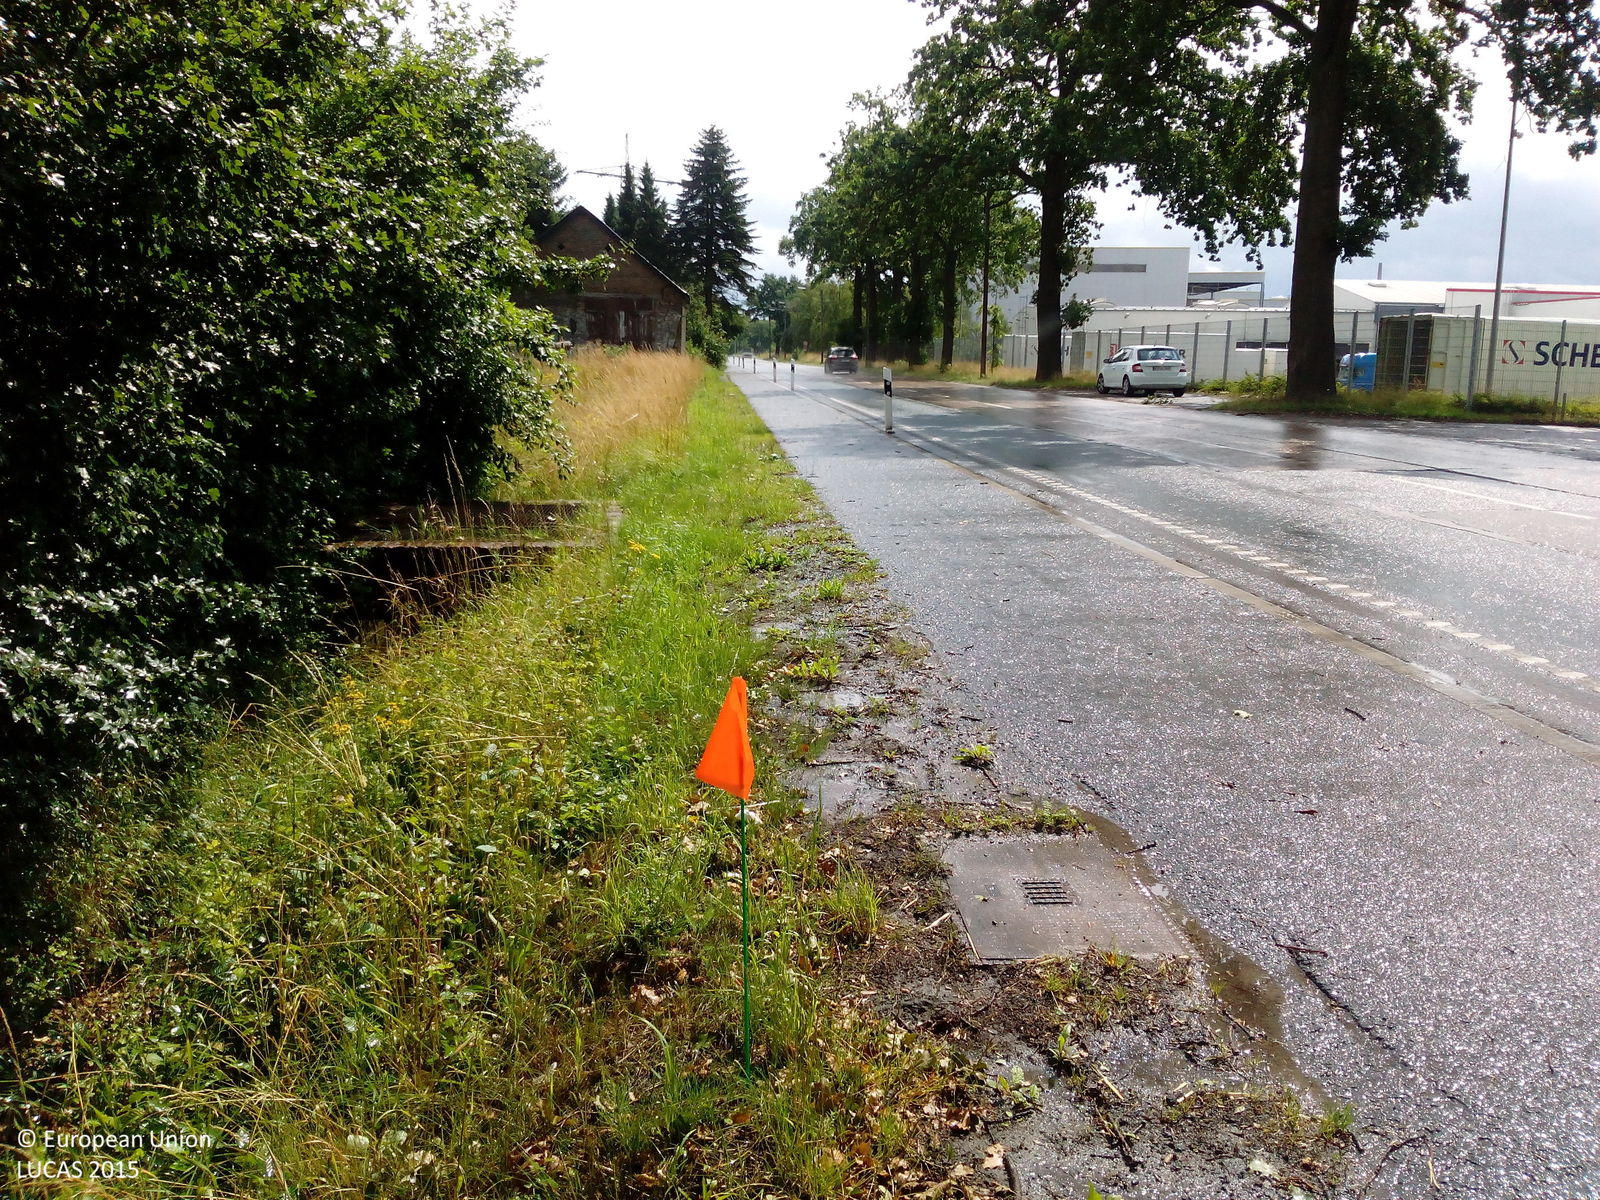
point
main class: Grassland
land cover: Grassland without tree/shrub cover
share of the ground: > 75 %
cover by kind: herbaceous plants 100 %
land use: Agriculture (excluding fallow land and kitchen gardens)
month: July
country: DE
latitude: 52.3070
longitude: 8.0205
